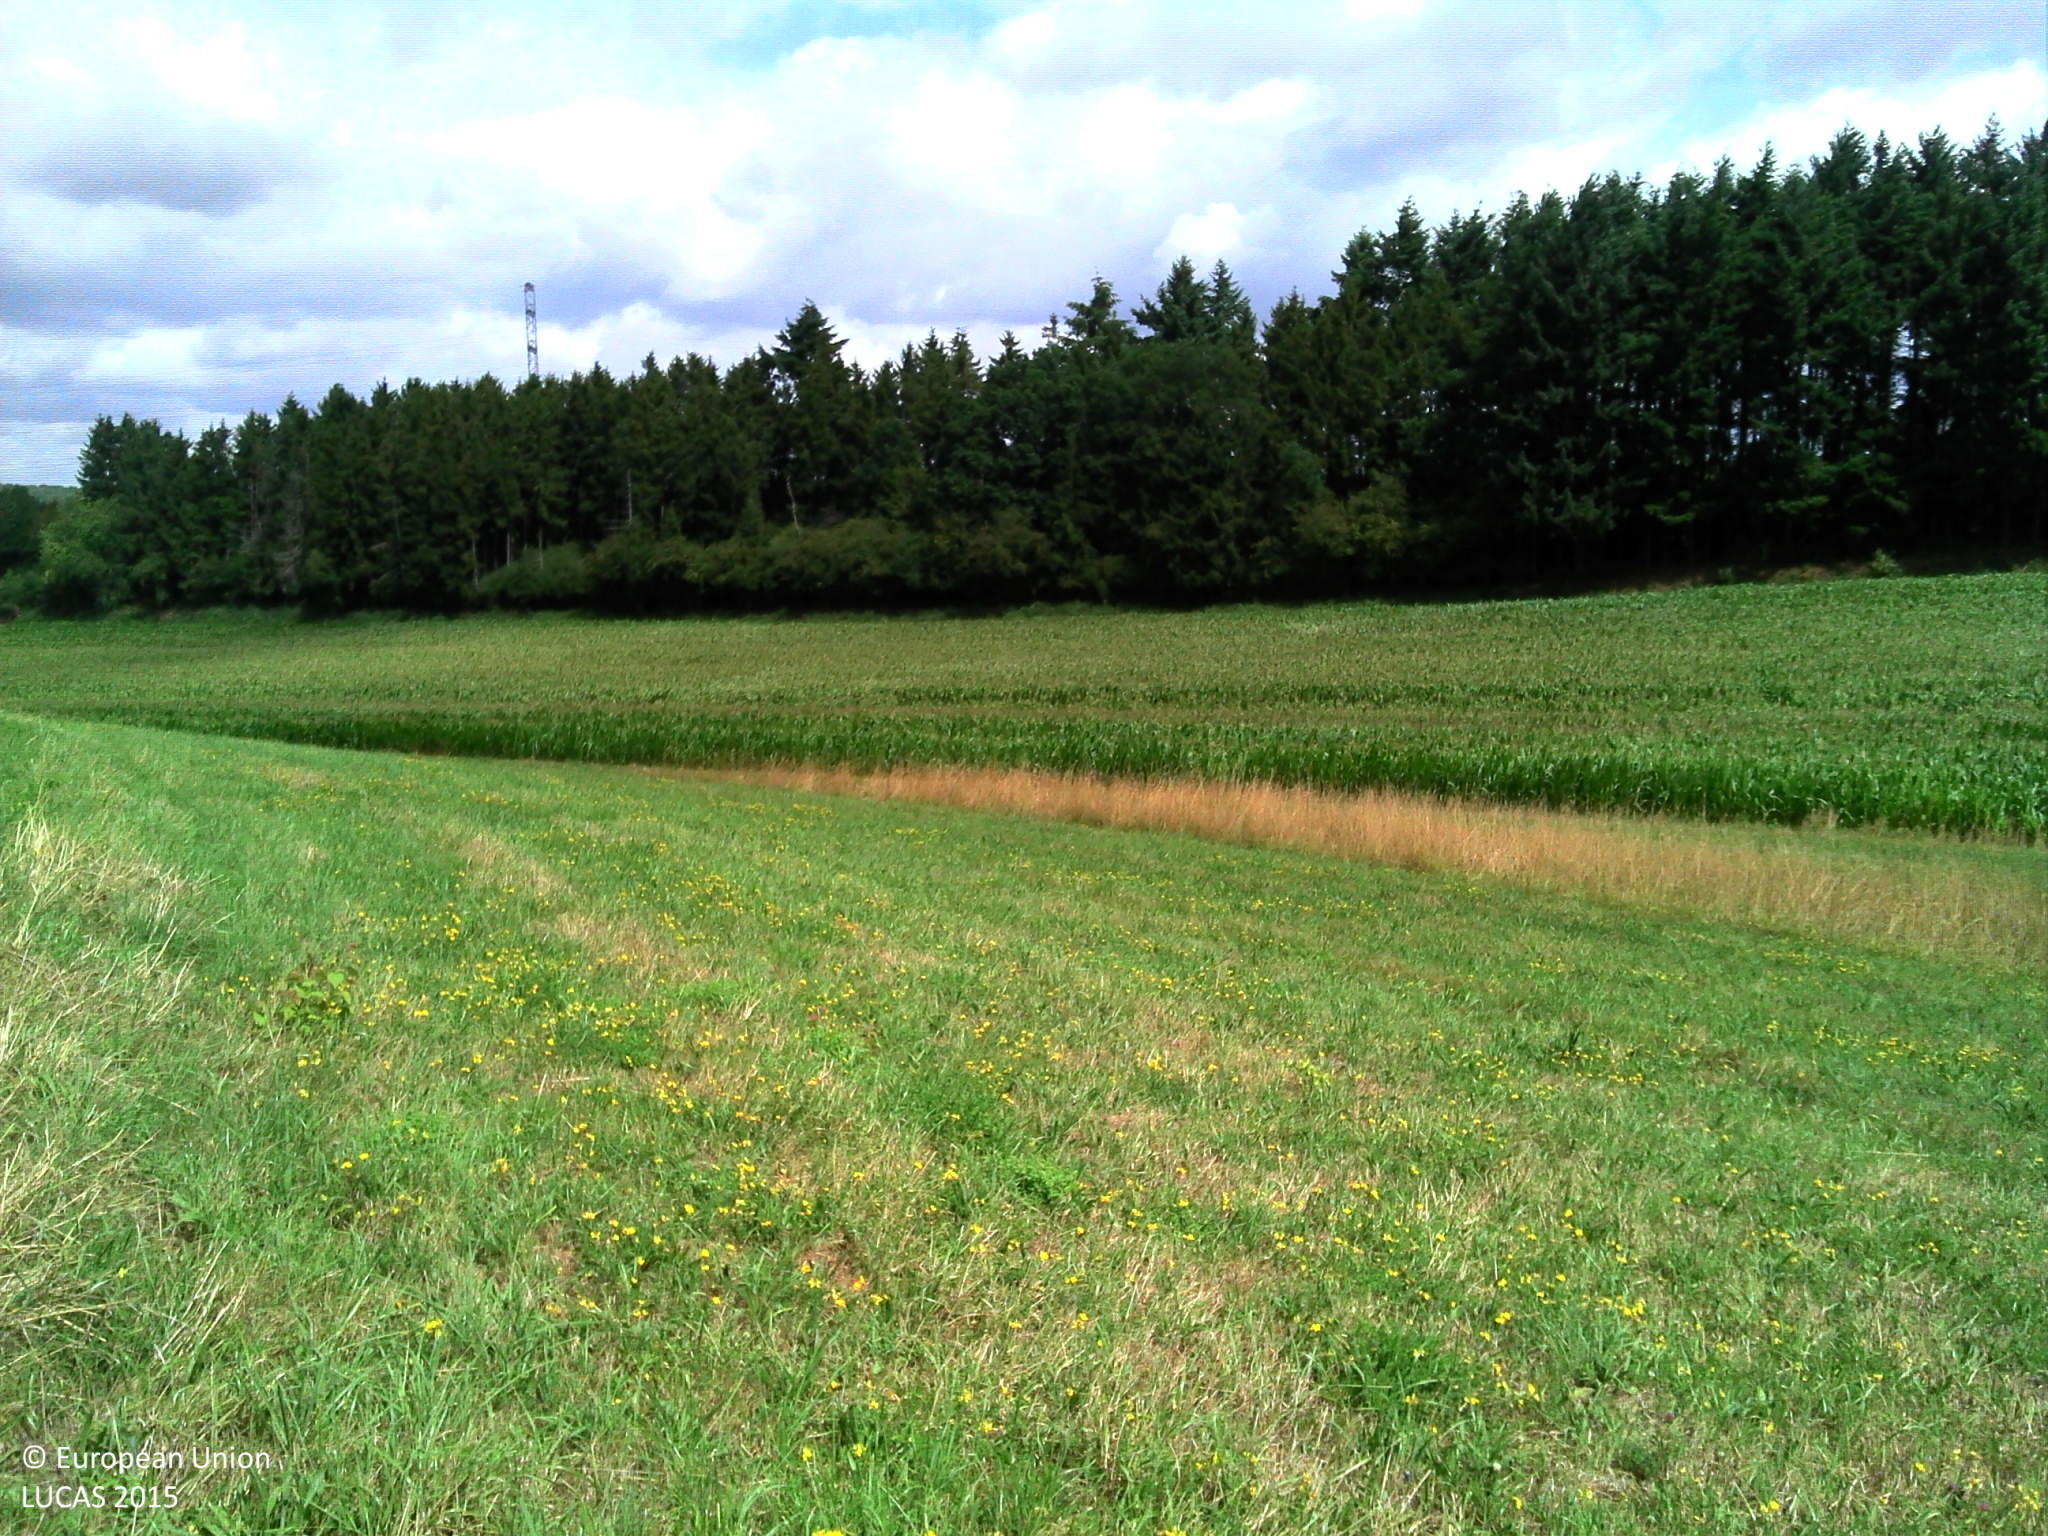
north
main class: Grassland
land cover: Grassland without tree/shrub cover
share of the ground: > 75 %
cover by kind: herbaceous plants 100 %
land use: Agriculture (excluding fallow land and kitchen gardens)
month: July
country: BE
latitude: 49.5650
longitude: 5.7542
